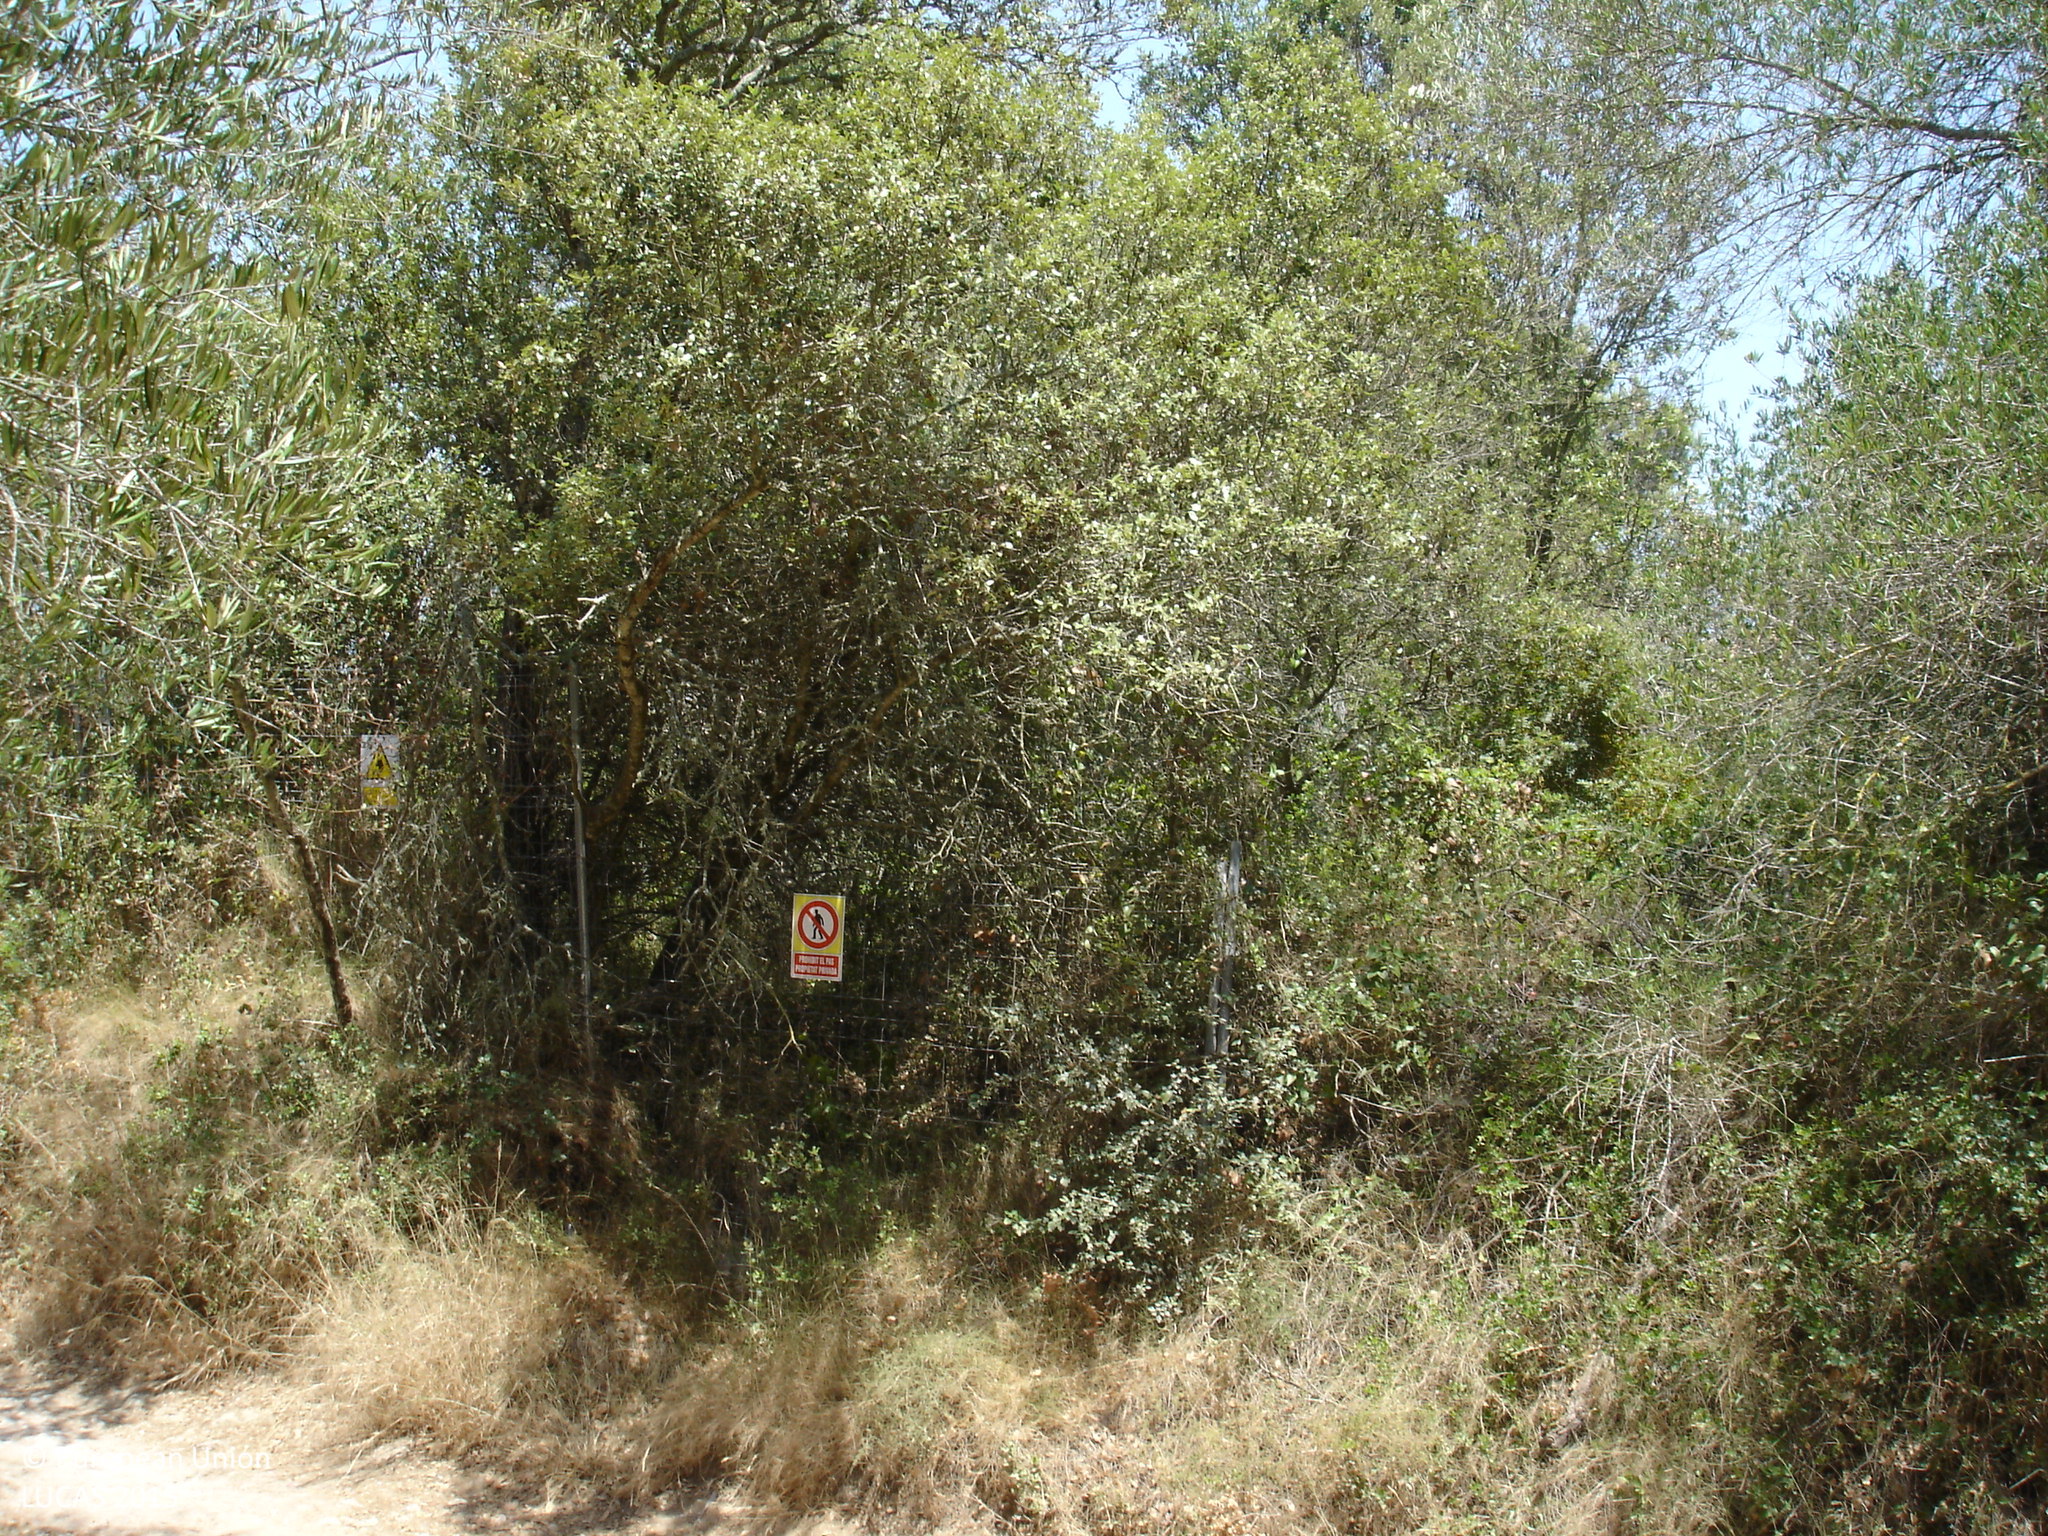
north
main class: Woodland
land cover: Other mixed woodland
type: thermophilous deciduous forest
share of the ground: > 75 %
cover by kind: broadleaved forest trees 50 %, coniferous forest trees 30 %, herbaceous plants 20 %
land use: Forestry
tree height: > 5 m
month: July
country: ES
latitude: 41.8577
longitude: 3.1142
